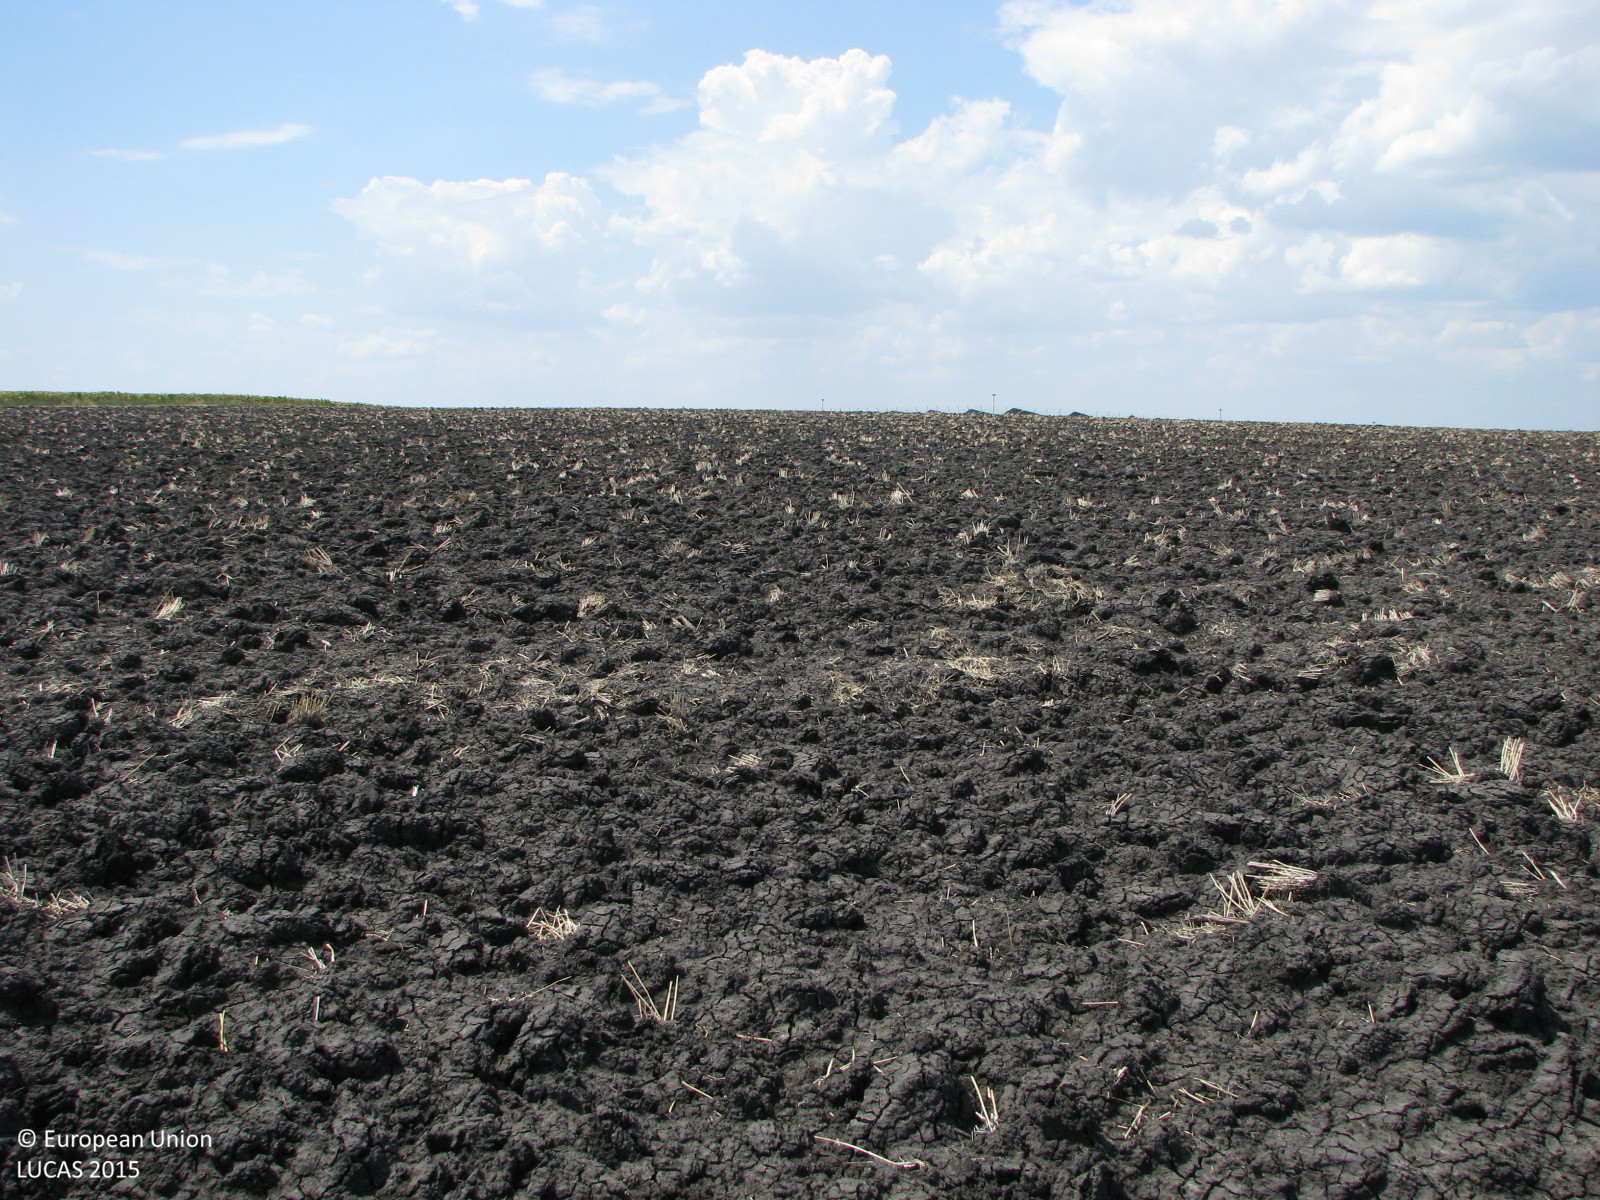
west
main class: Cropland
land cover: Common wheat
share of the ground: < 10 %
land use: Agriculture (excluding fallow land and kitchen gardens)
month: August
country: BG
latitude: 42.4184
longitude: 26.4600
